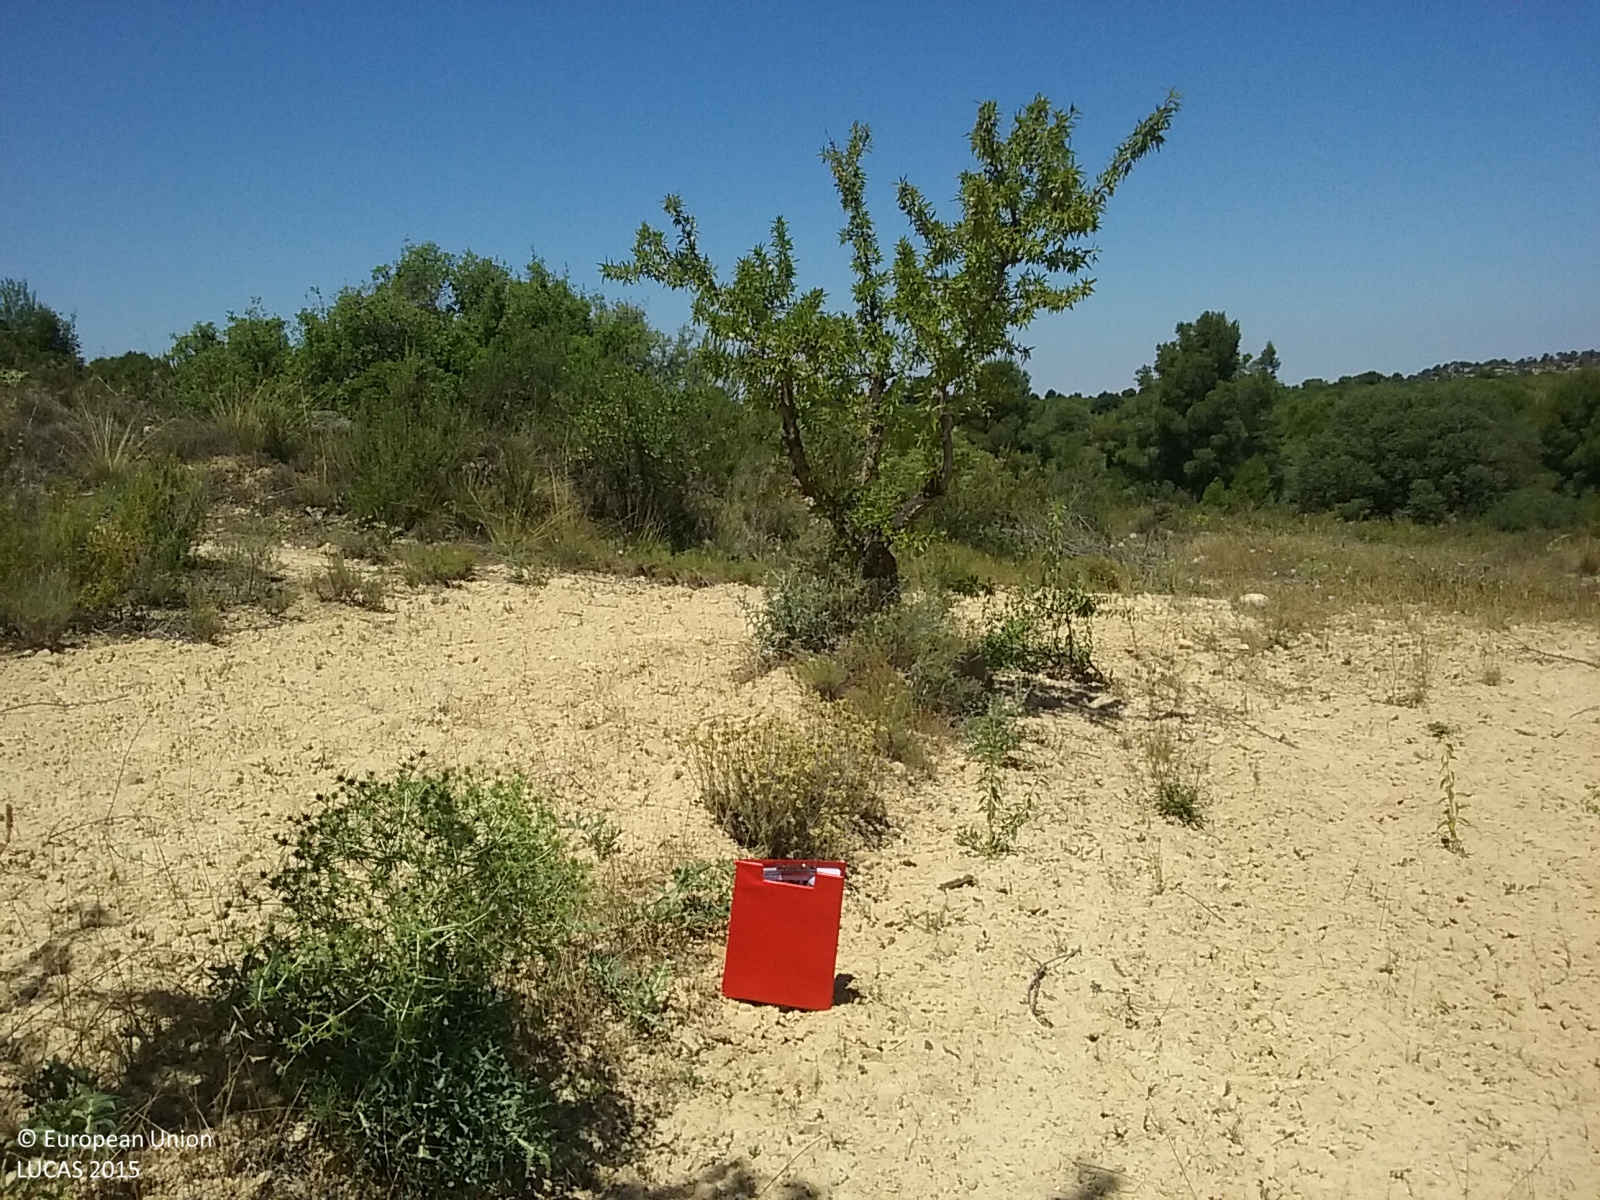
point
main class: Cropland
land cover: Nuts trees
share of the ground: 25 - 50 %
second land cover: Spontaneously vegetated surfaces
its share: 10 - 25 %
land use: Agriculture (excluding fallow land and kitchen gardens)
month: June
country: ES
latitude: 41.1153
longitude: 0.3081
